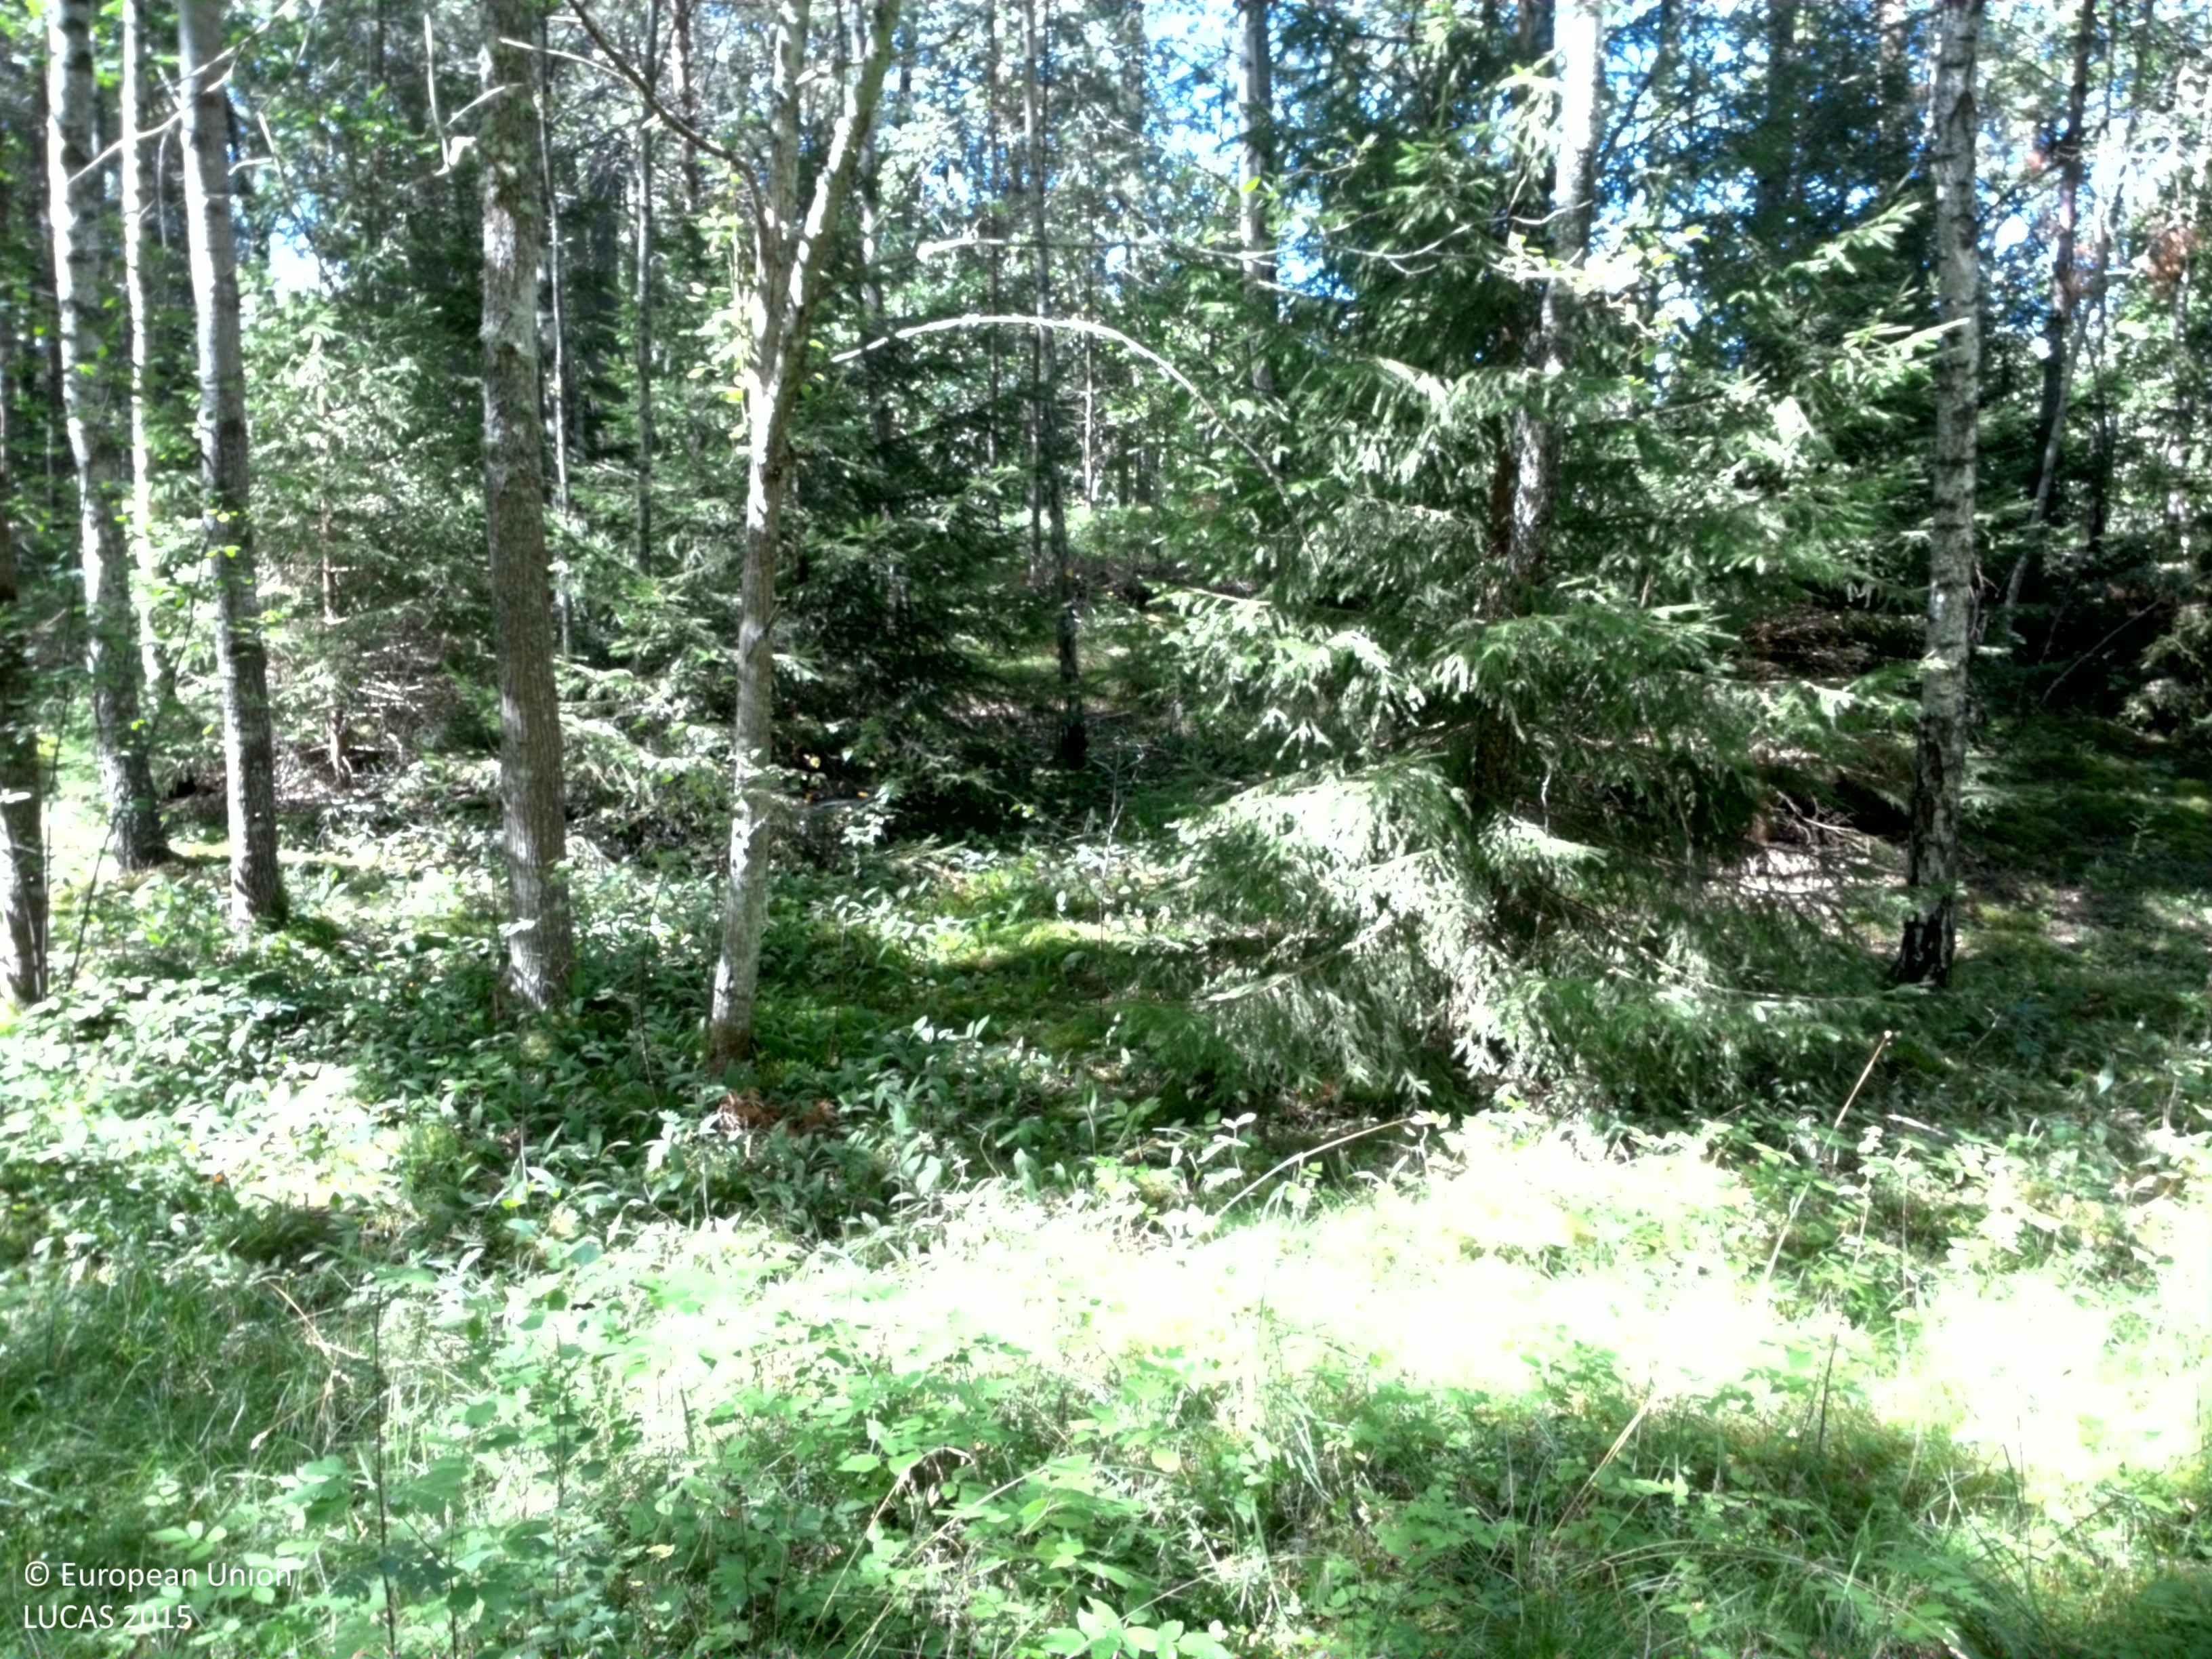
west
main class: Woodland
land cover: Pine dominated mixed woodland
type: boreal forest
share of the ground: 25 - 50 %
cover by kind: herbaceous plants 30 %, coniferous forest trees 25 %, broadleaved forest trees 25 %, lichens and mosses 15 %, shrubs 5 %
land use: Forestry
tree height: > 5 m
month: August
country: SE
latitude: 58.2351
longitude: 13.2134
